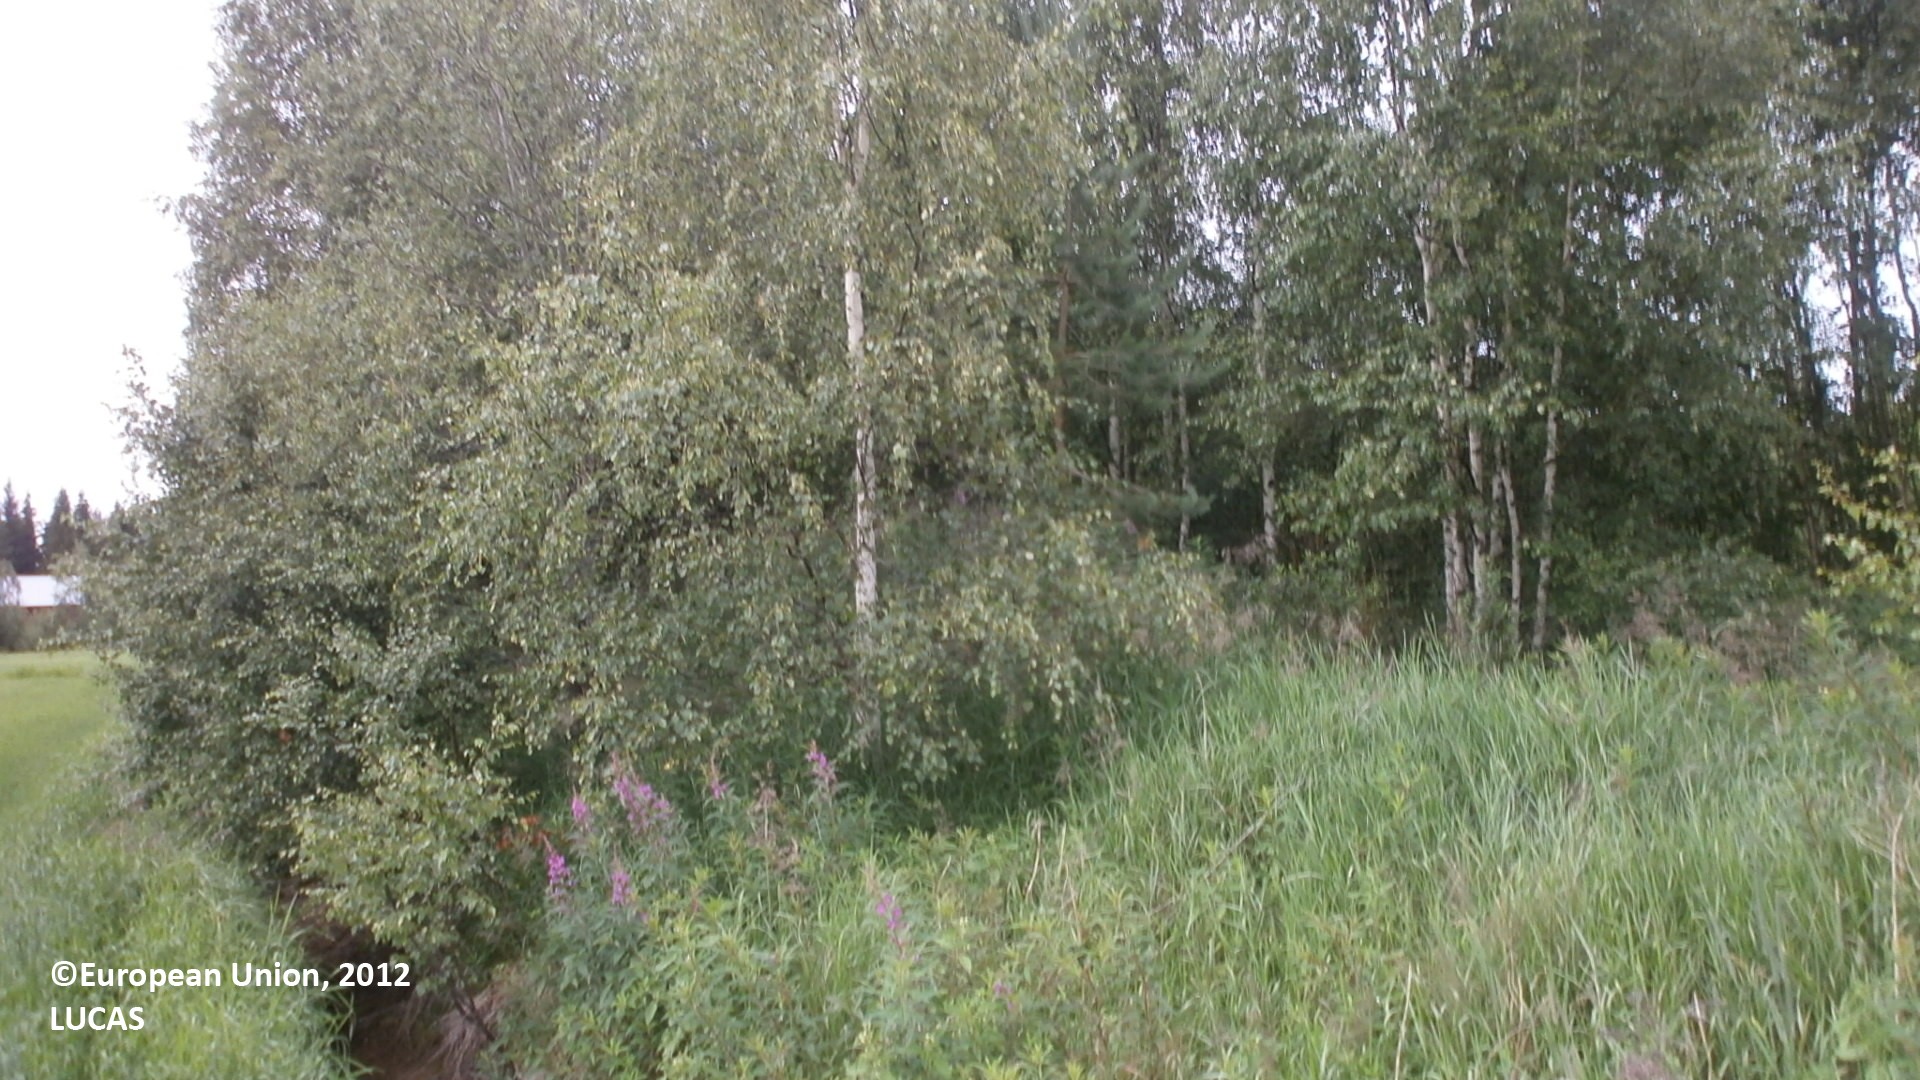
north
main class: Cropland
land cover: Barley
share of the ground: > 75 %
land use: Agriculture (excluding fallow land and kitchen gardens)
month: July
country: FI
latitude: 64.2282
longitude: 24.0610
